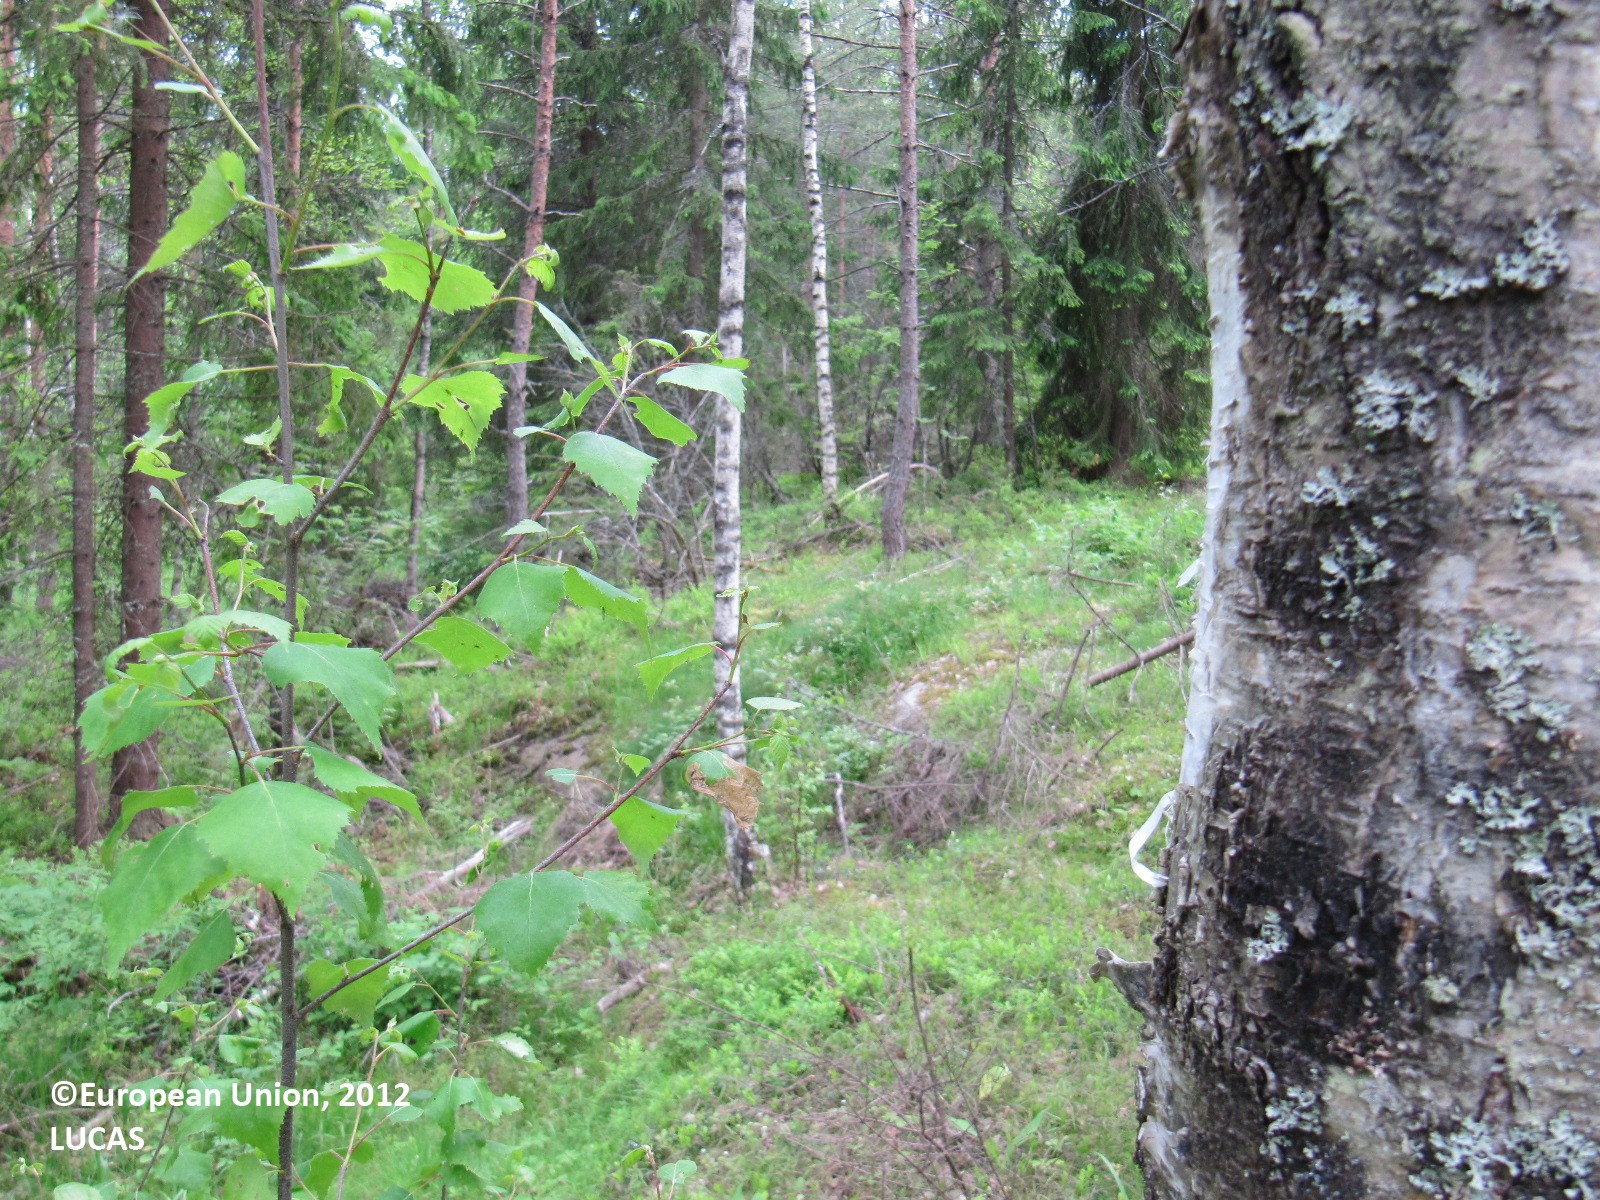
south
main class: Woodland
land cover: Pine dominated mixed woodland
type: boreal forest
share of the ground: 50 - 75 %
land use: Forestry
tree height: > 5 m
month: June
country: FI
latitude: 60.3077
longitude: 24.3110
